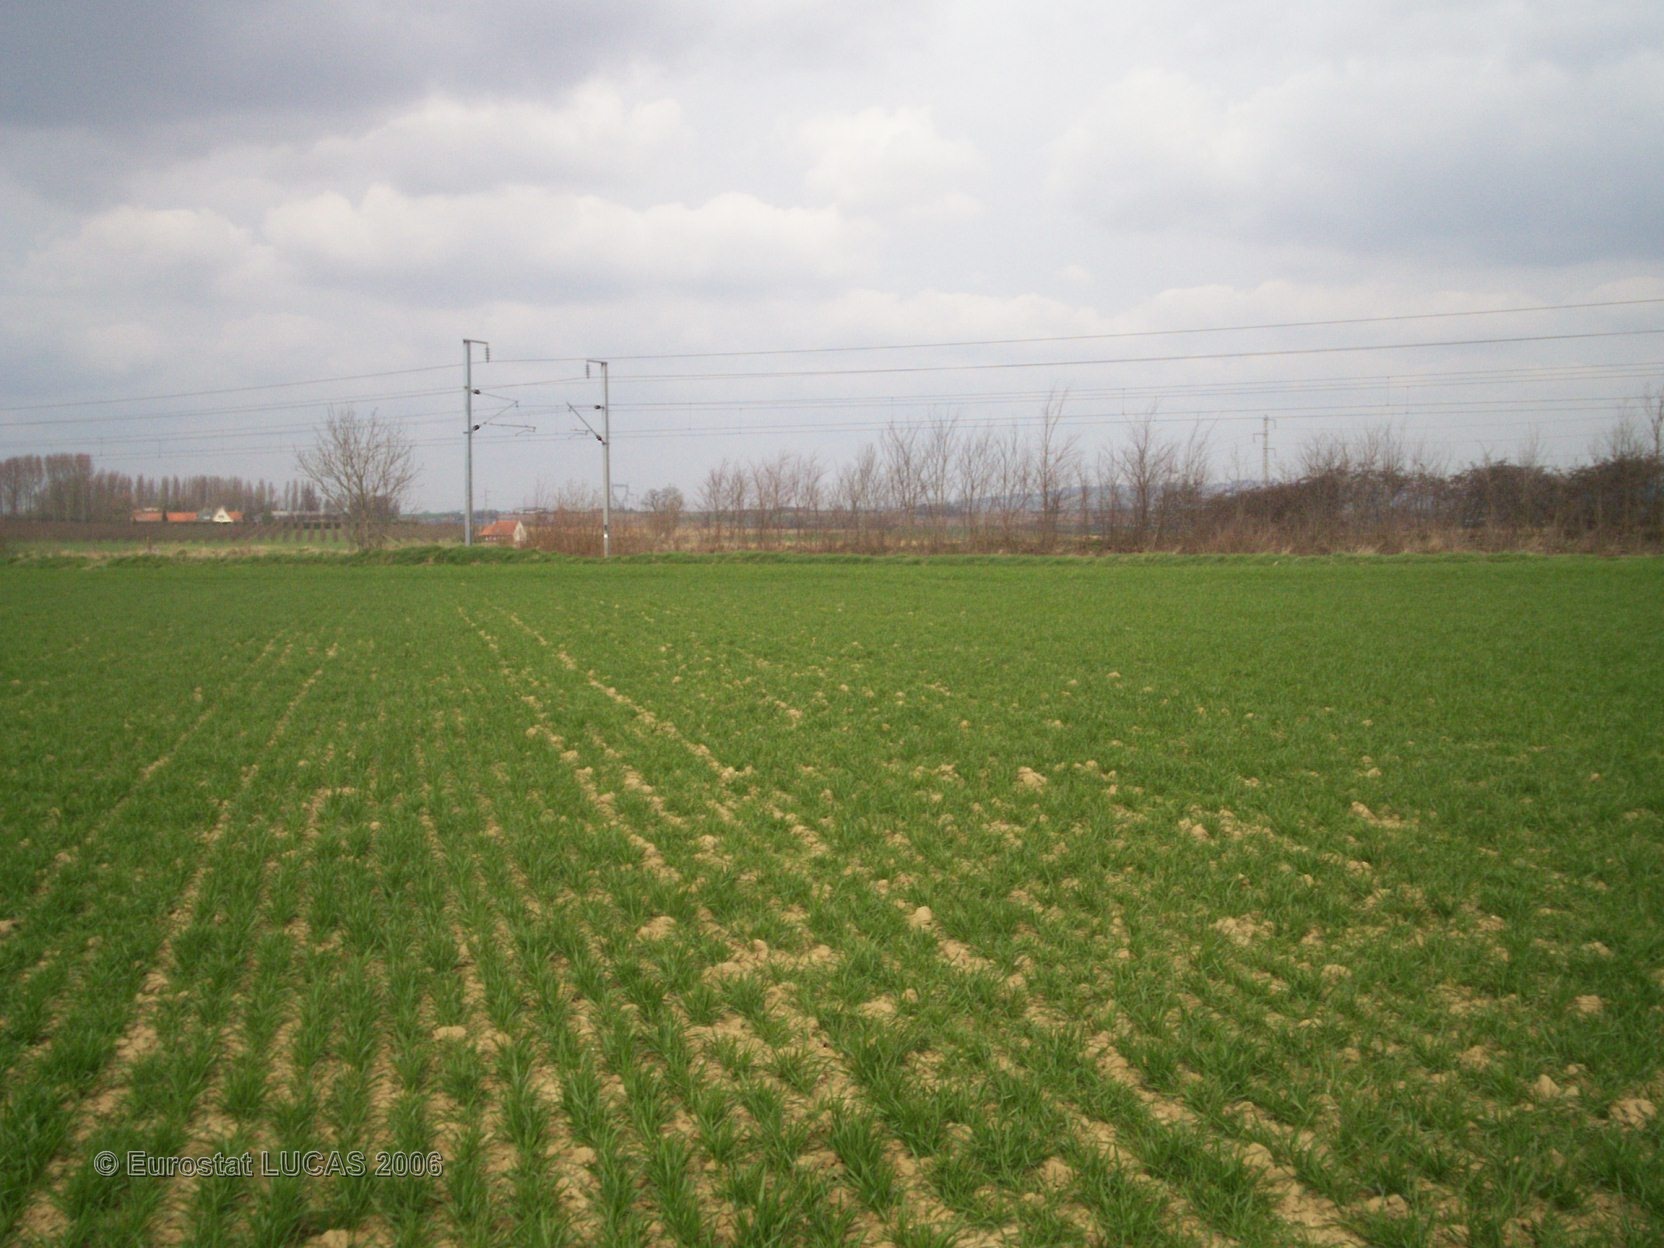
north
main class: Cropland
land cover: Common wheat
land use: Agriculture (excluding fallow land and kitchen gardens)
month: April
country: FR
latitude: 50.7312
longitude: 2.4925
